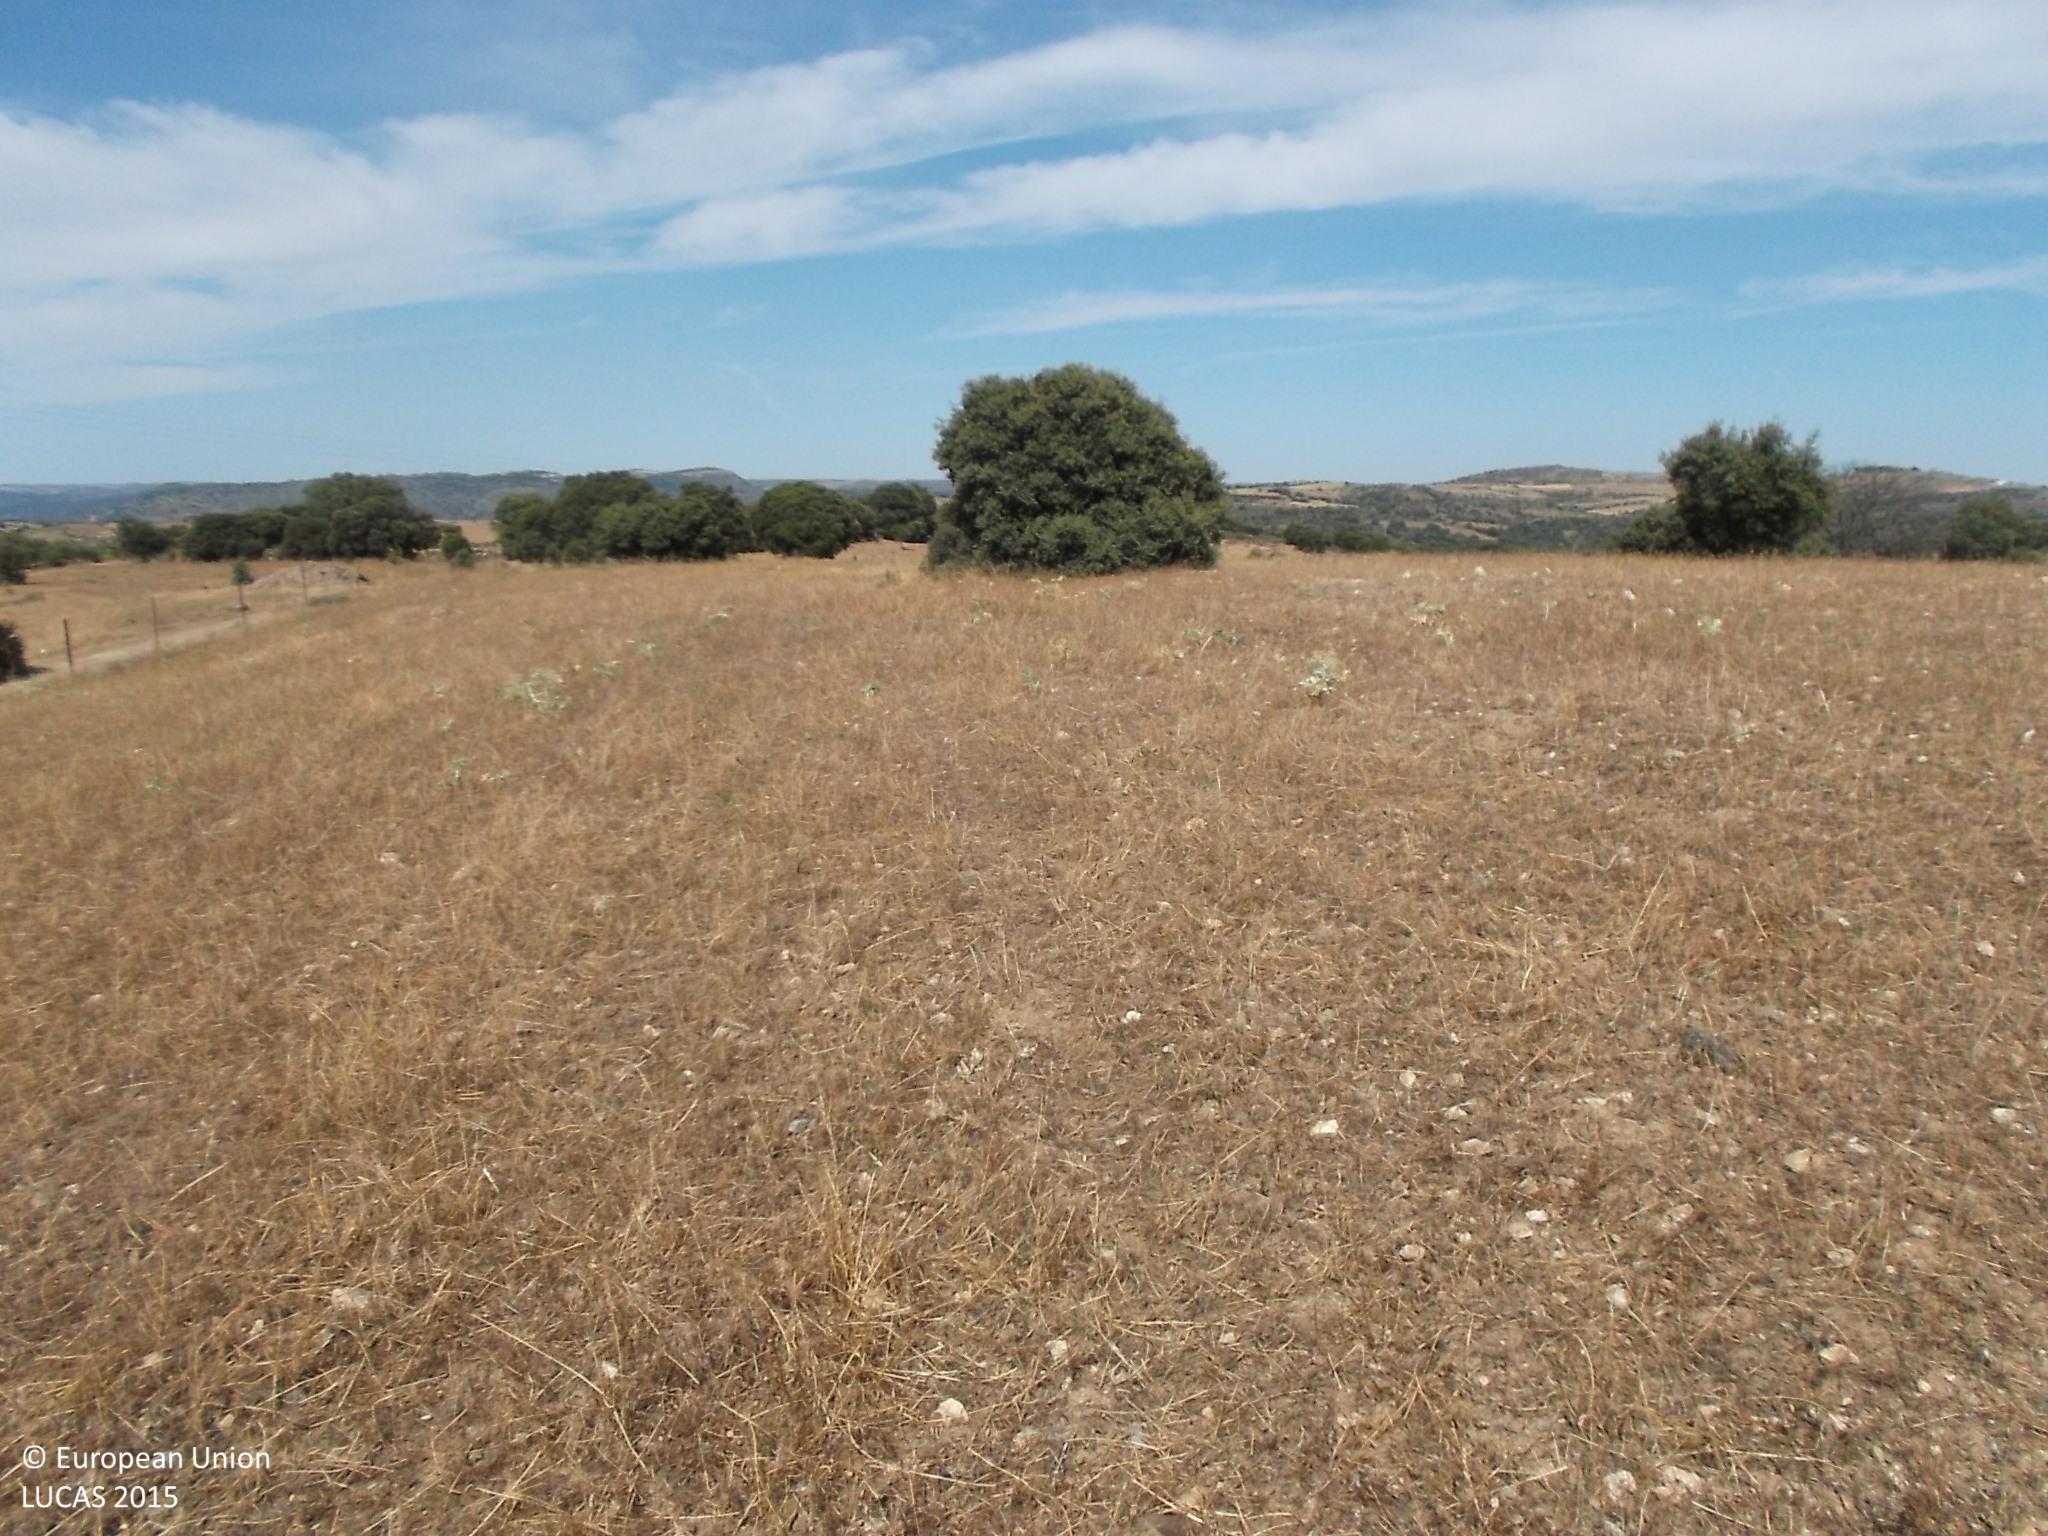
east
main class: Grassland
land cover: Grassland without tree/shrub cover
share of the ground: > 75 %
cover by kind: herbaceous plants 95 %, shrubs 5 %
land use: Agriculture (excluding fallow land and kitchen gardens)
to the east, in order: Grassland without tree/shrub cover; Fences; Grass margins; Broadleaved woodland; Tracks; Shrubland with sparse tree cover
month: July
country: ES
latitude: 40.9907
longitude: -6.8517
